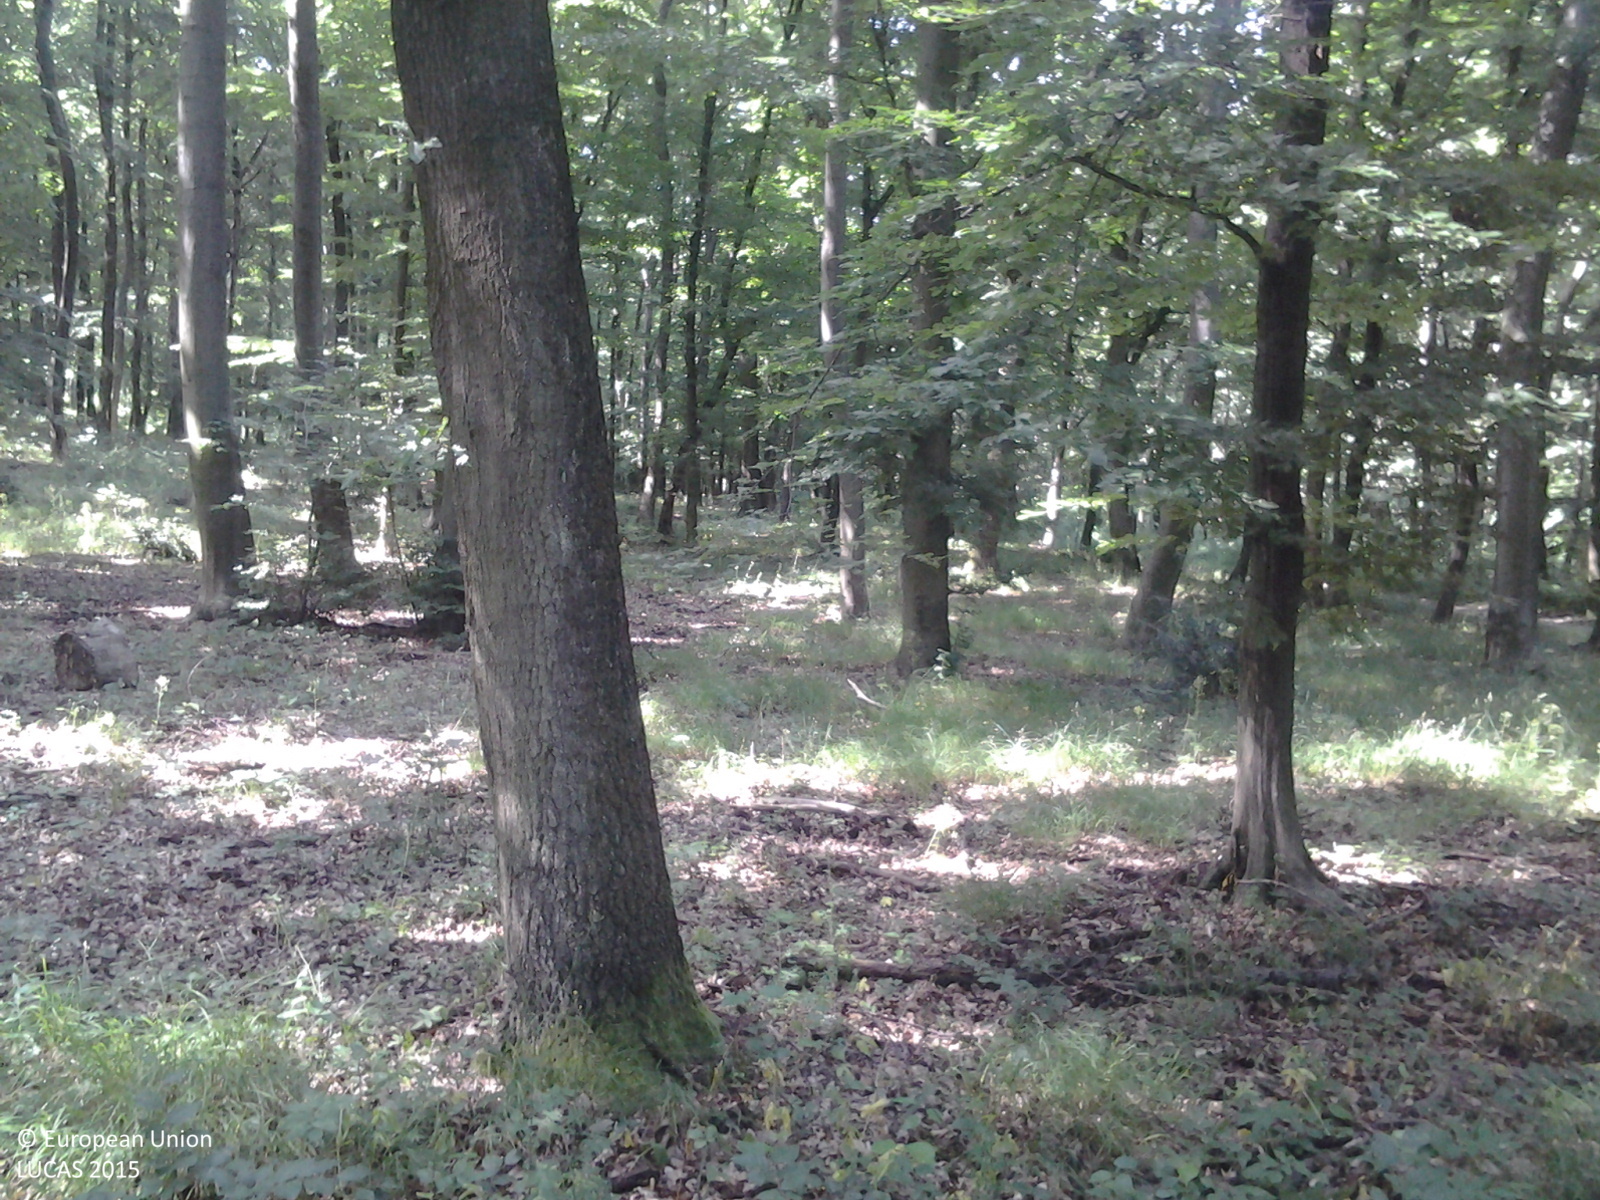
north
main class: Woodland
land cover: Broadleaved woodland
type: beech forest
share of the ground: > 75 %
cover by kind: broadleaved forest trees 100 %
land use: Forestry
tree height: > 5 m
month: June
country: HU
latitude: 46.8637
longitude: 17.2592
